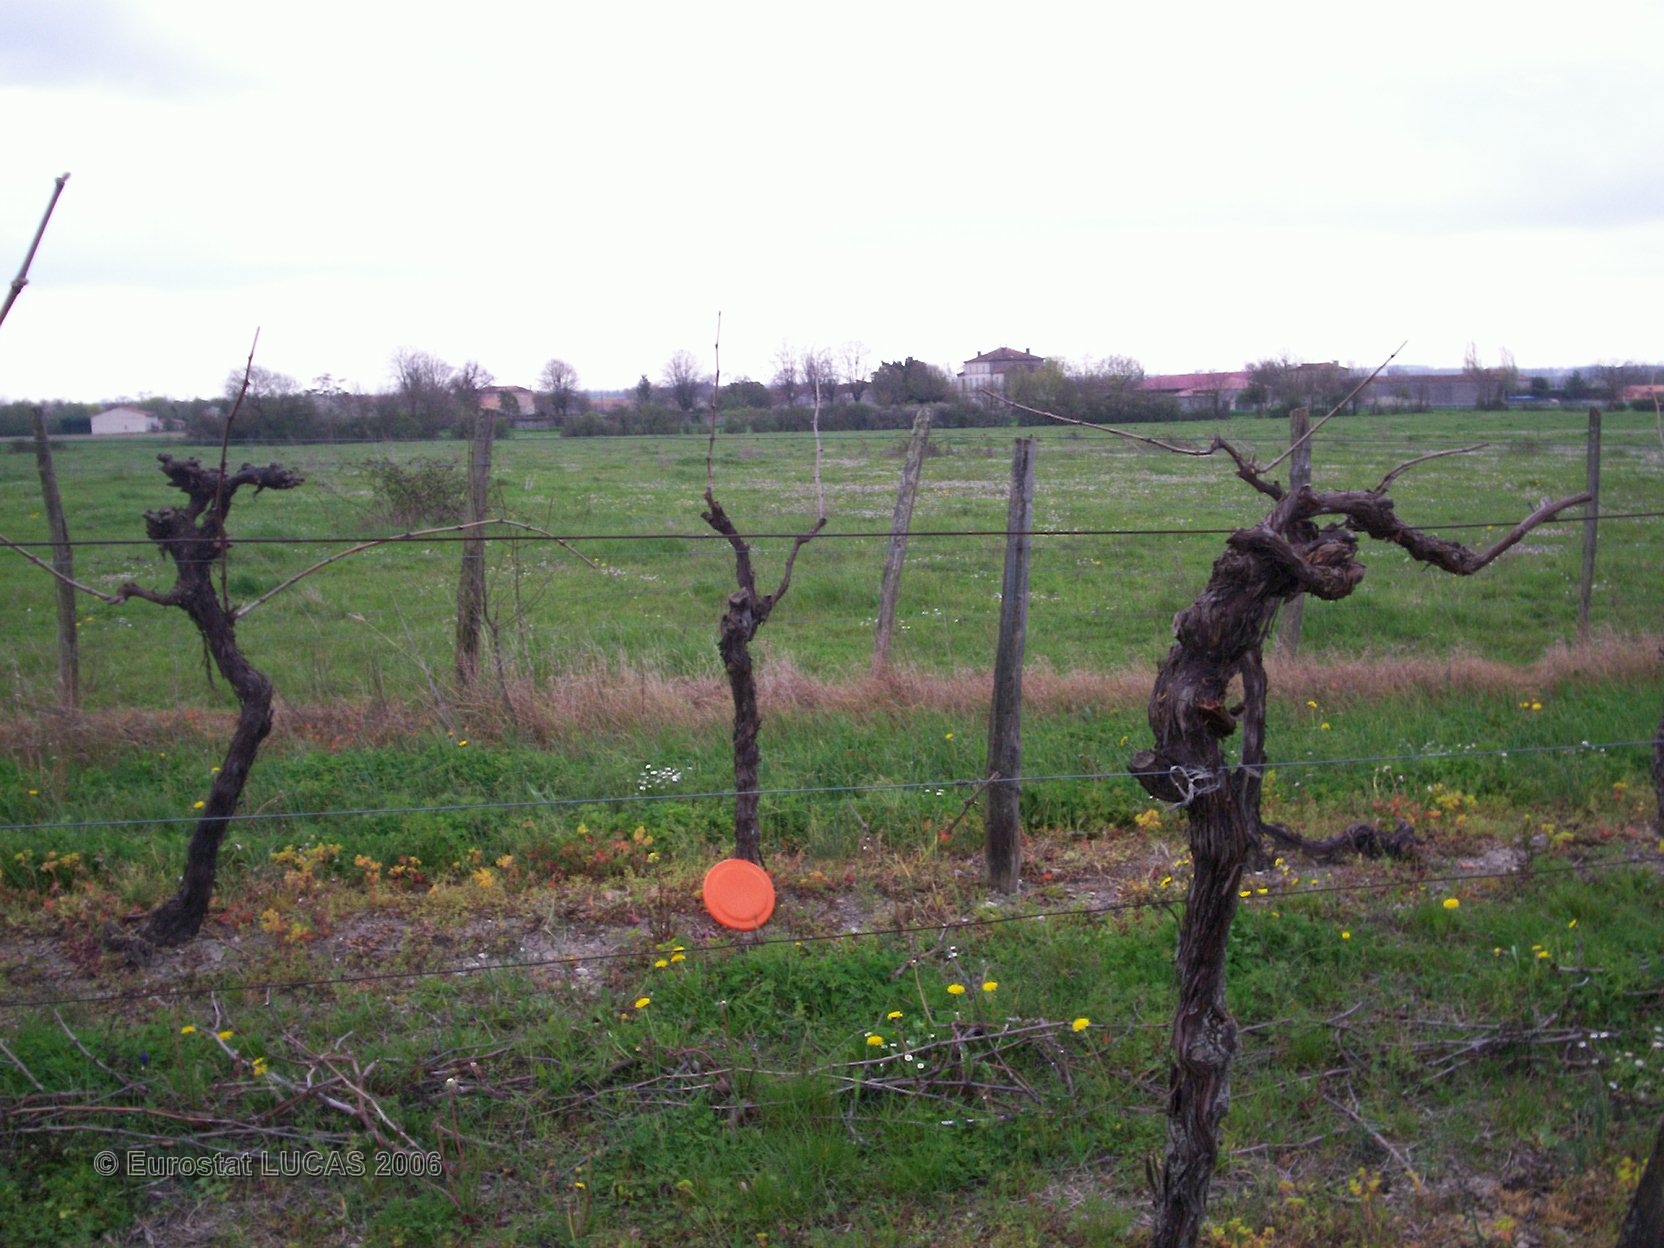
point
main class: Cropland
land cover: Vineyards
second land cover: Grassland with sparse tree/shrub cover
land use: Agriculture (excluding fallow land and kitchen gardens)
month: April
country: FR
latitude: 45.7724
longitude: -0.1922
